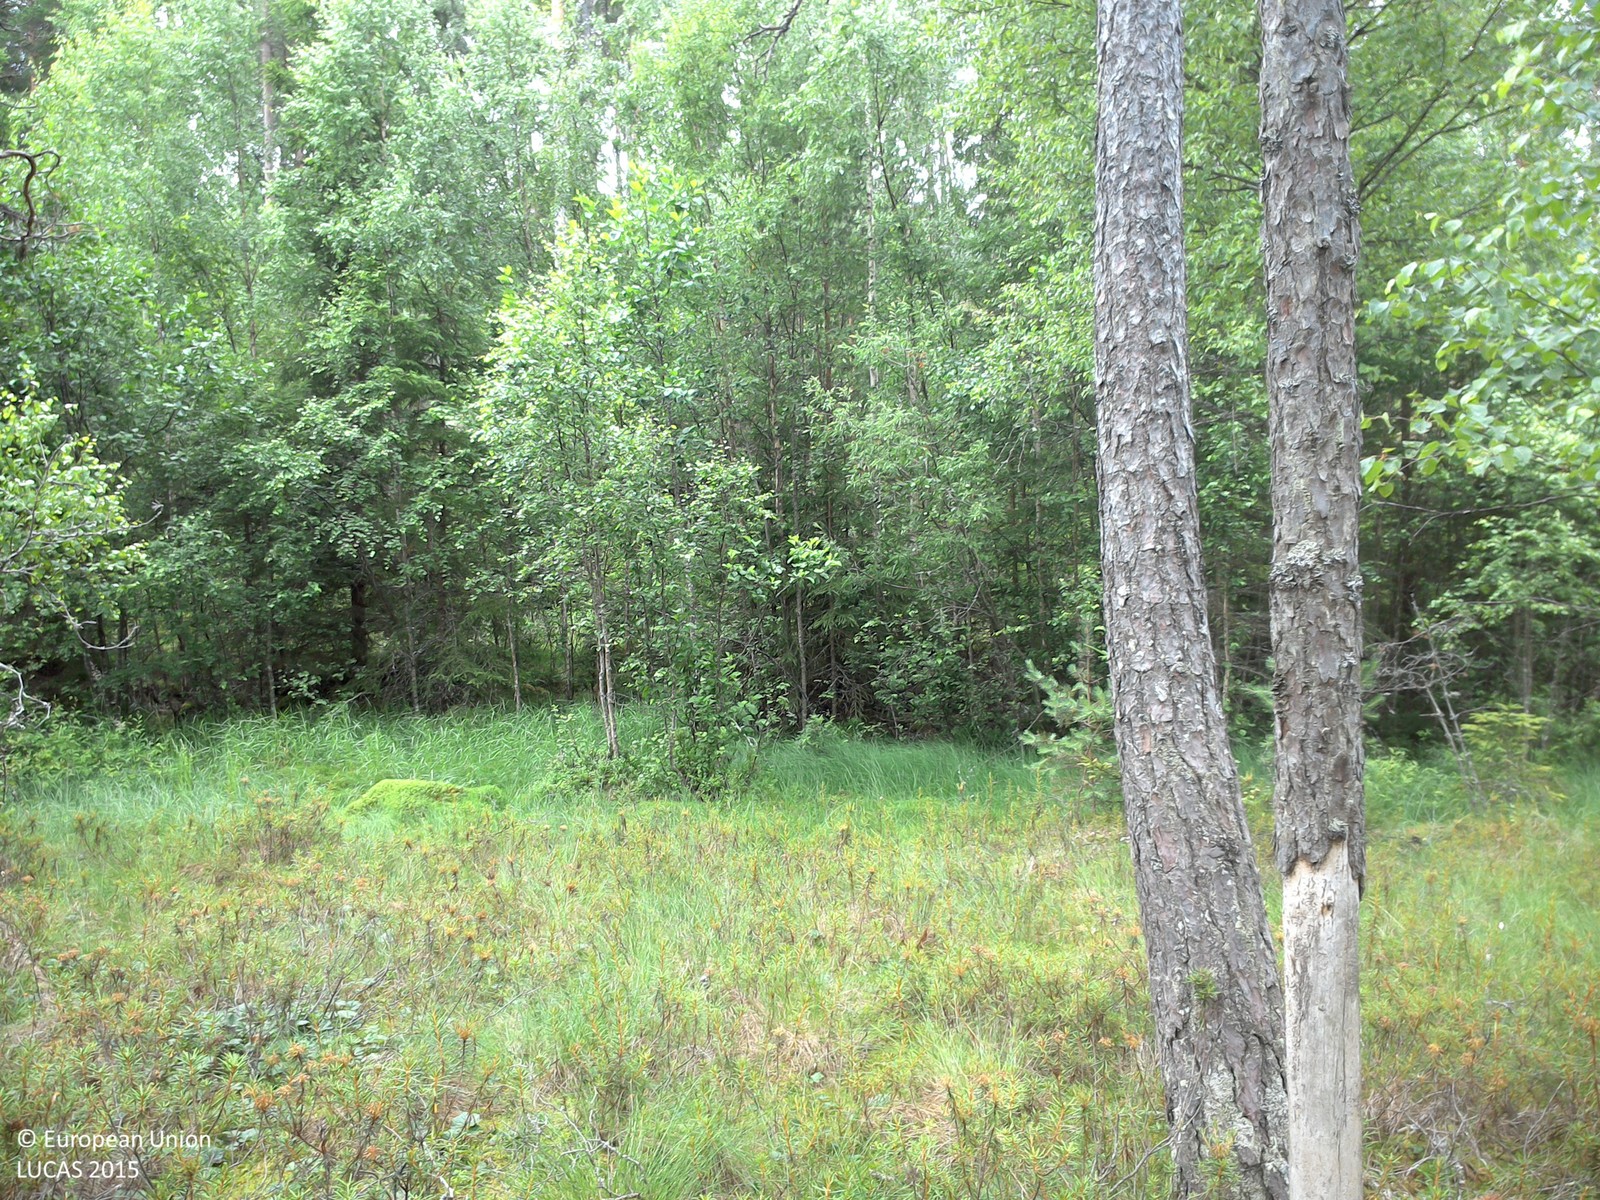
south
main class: Woodland
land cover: Pine dominated coniferous woodland
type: boreal forest
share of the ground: 25 - 50 %
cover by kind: herbaceous plants 40 %, coniferous forest trees 30 %, lichens and mosses 30 %
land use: Forestry
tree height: > 5 m
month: July
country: SE
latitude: 57.8520
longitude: 15.9785
